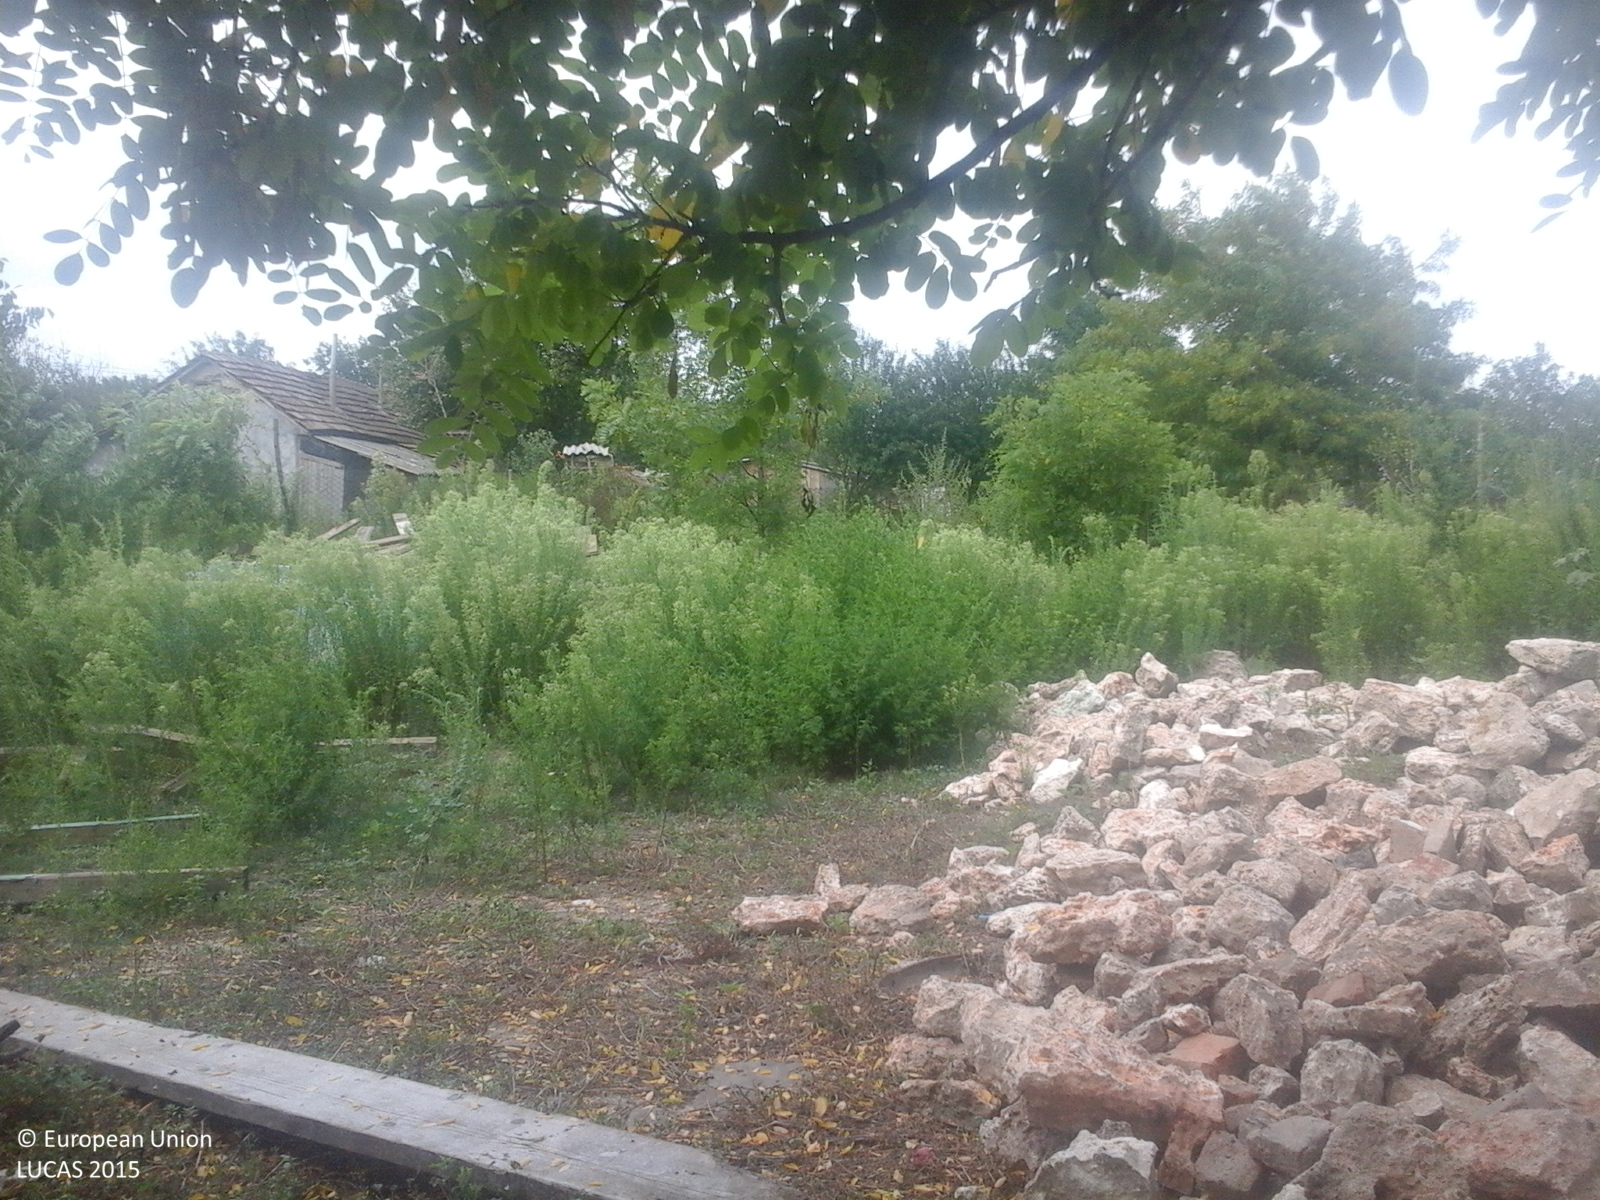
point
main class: Grassland
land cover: Spontaneously vegetated surfaces
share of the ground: > 75 %
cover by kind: herbaceous plants 100 %
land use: Fallow land
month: August
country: RO
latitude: 43.9013
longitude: 28.2228
